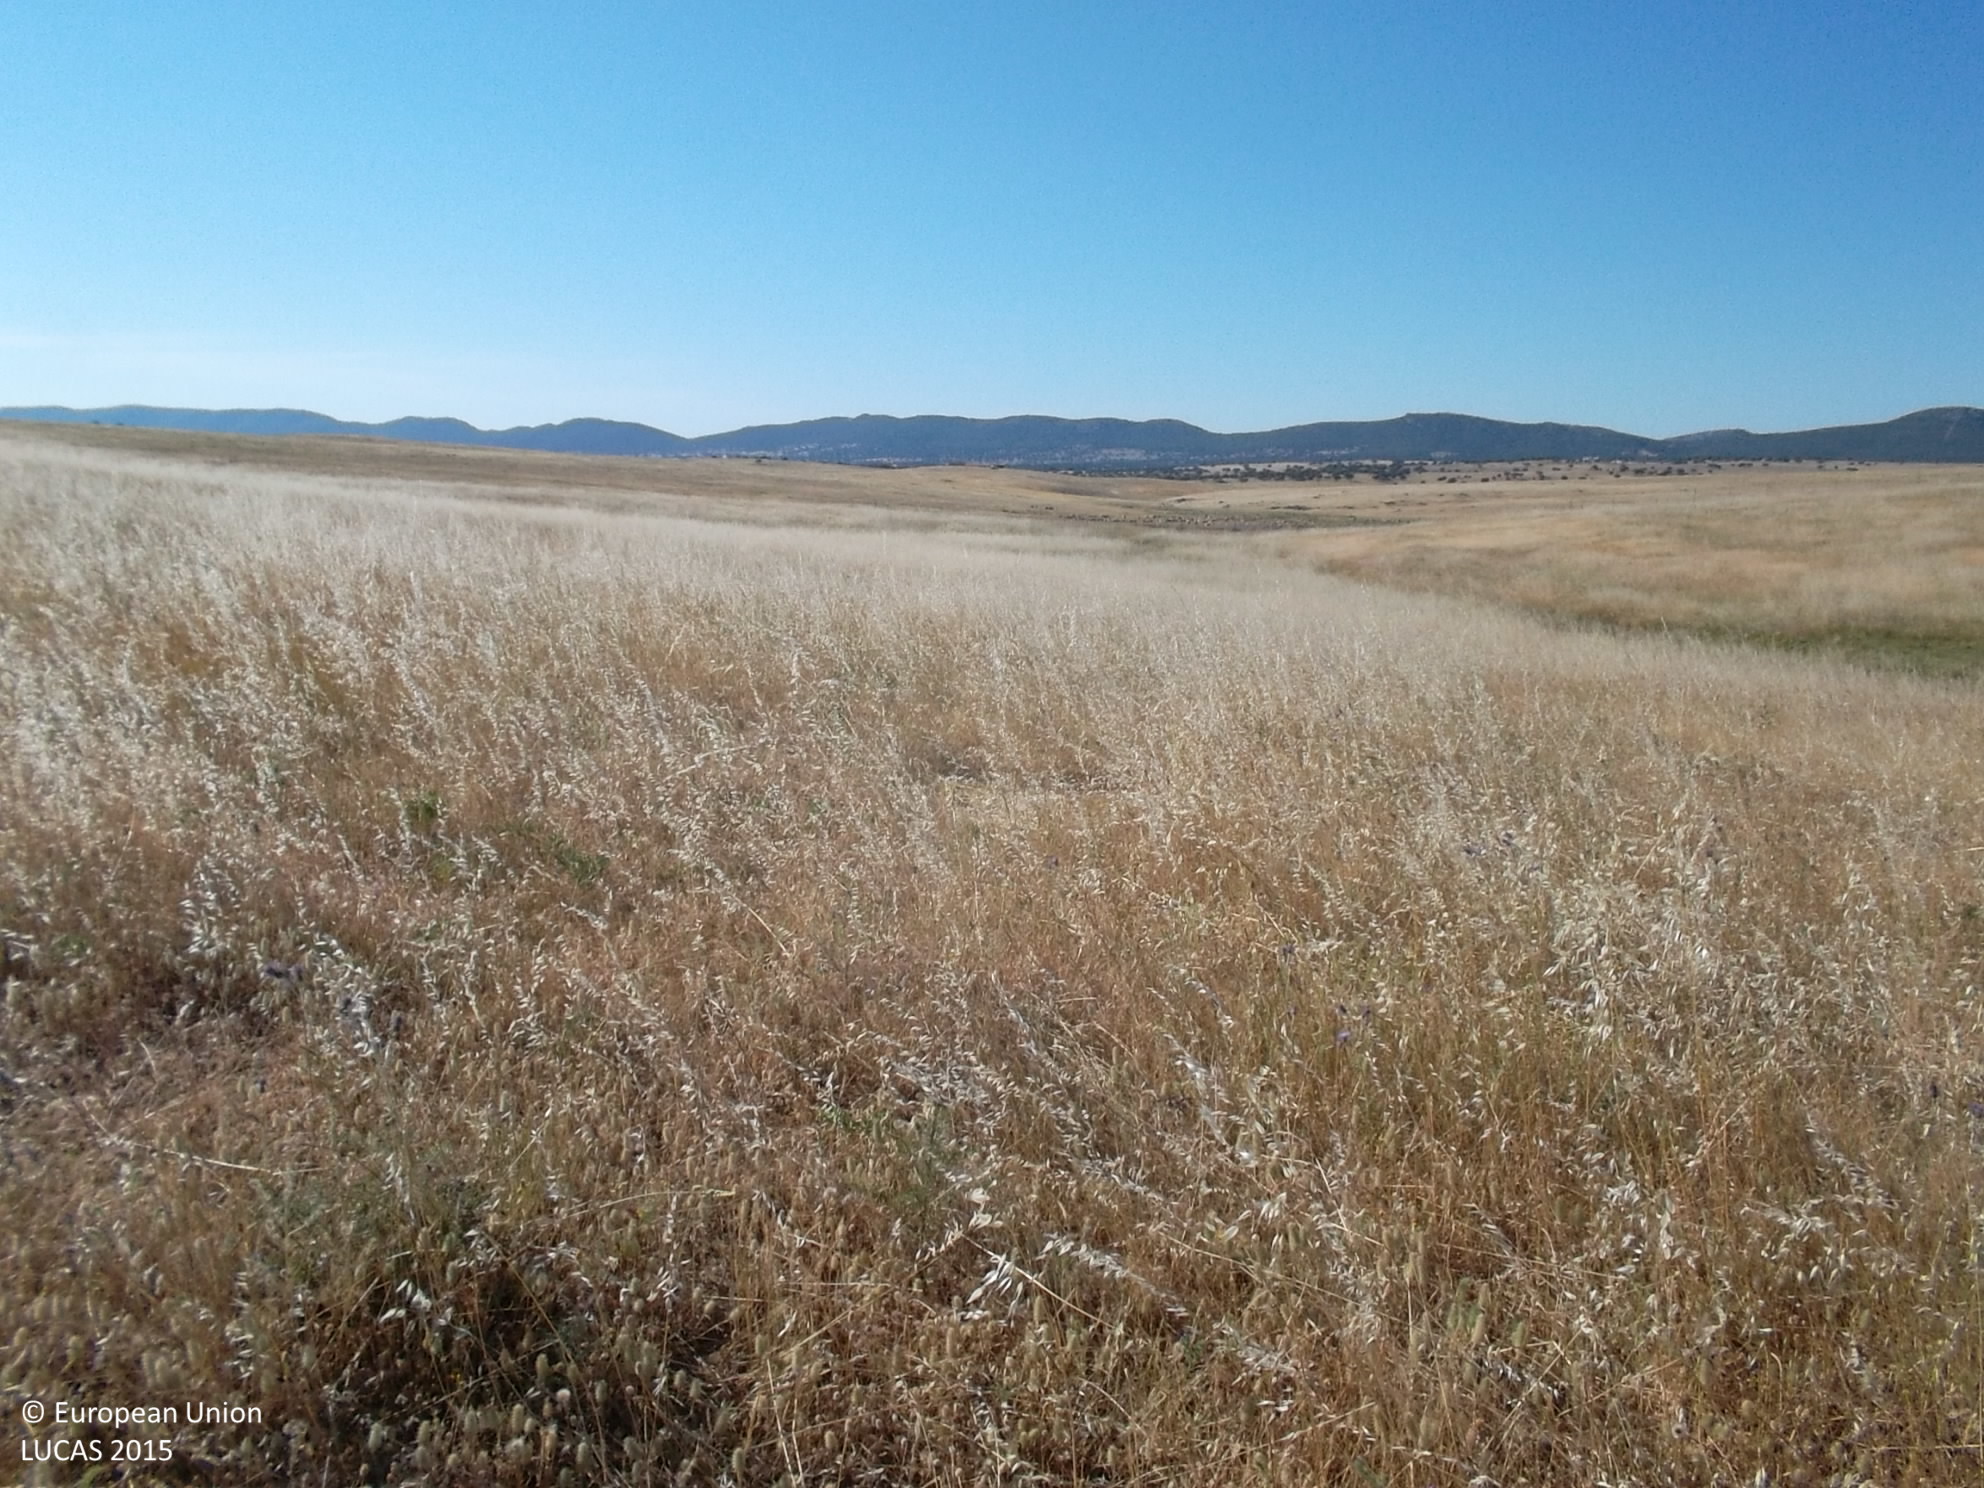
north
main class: Grassland
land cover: Grassland without tree/shrub cover
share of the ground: 25 - 50 %
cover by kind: herbaceous plants 100 %
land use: Agriculture (excluding fallow land and kitchen gardens)
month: May
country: ES
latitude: 38.6386
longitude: -4.4632
